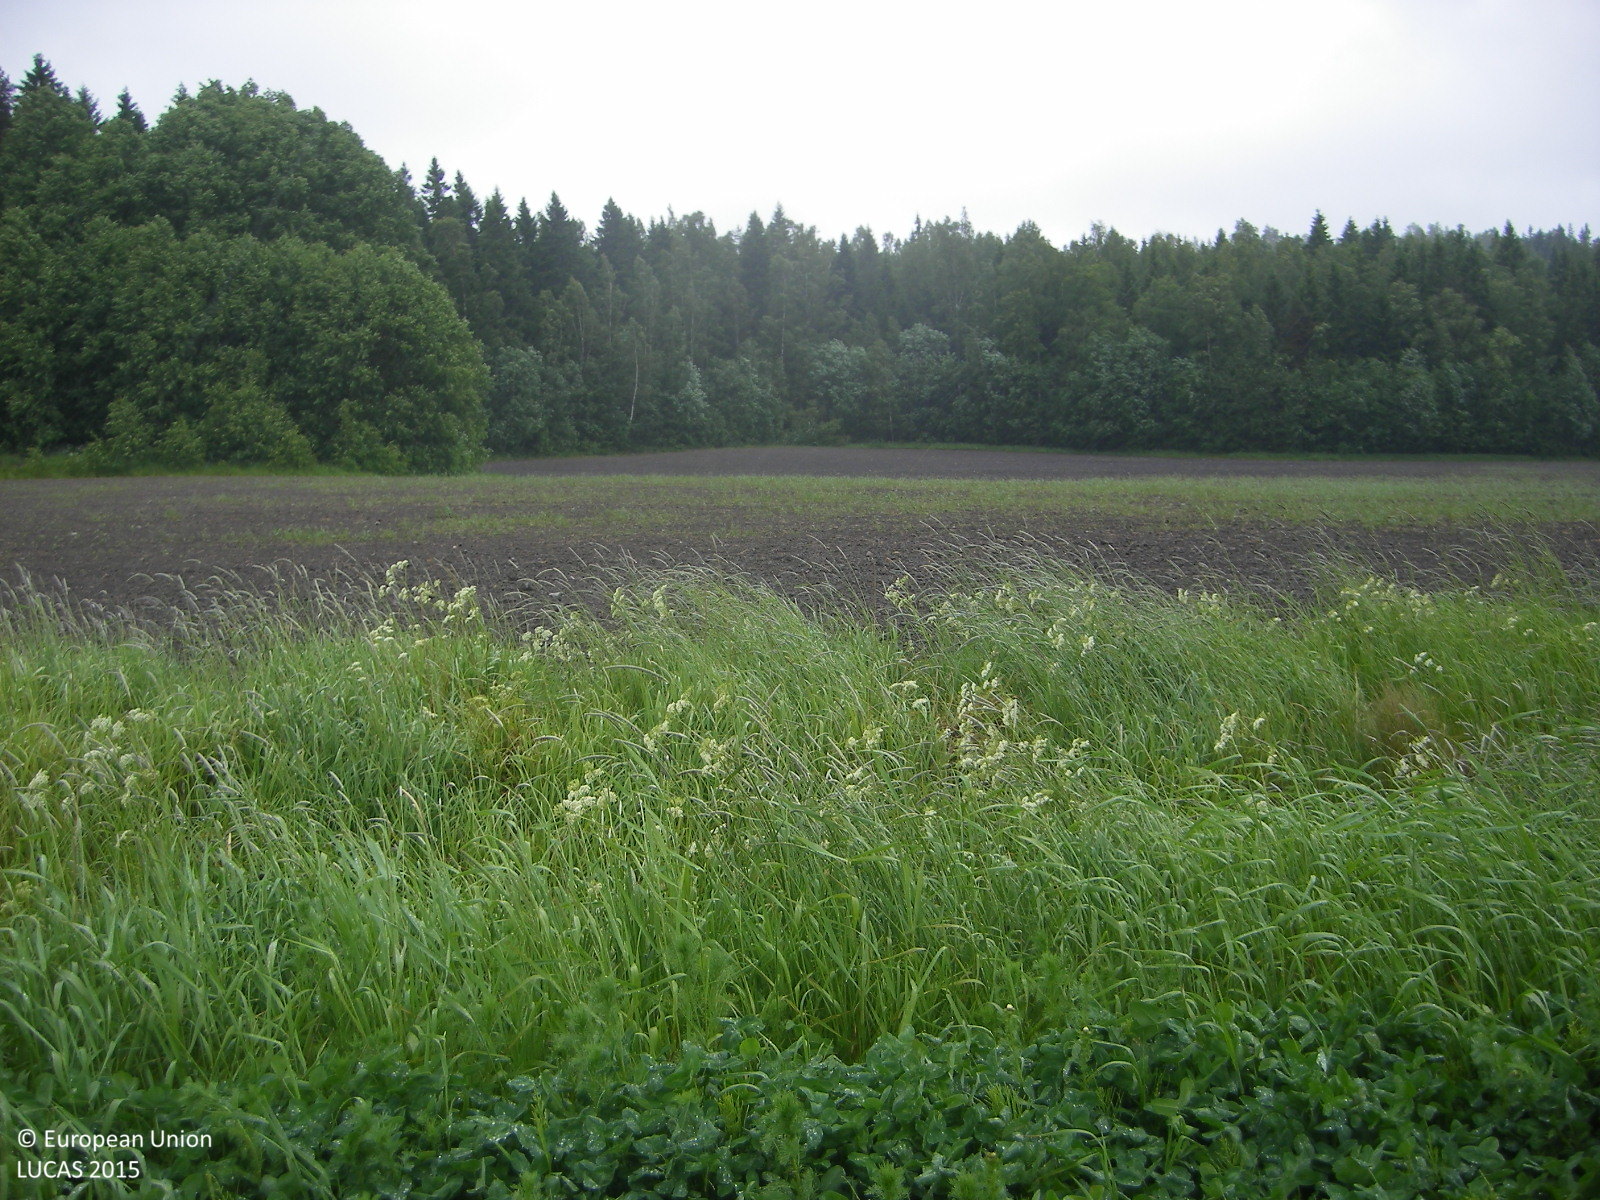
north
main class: Cropland
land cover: Clovers
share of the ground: > 75 %
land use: Agriculture (excluding fallow land and kitchen gardens)
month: June
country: FI
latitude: 60.1040
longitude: 24.1494
